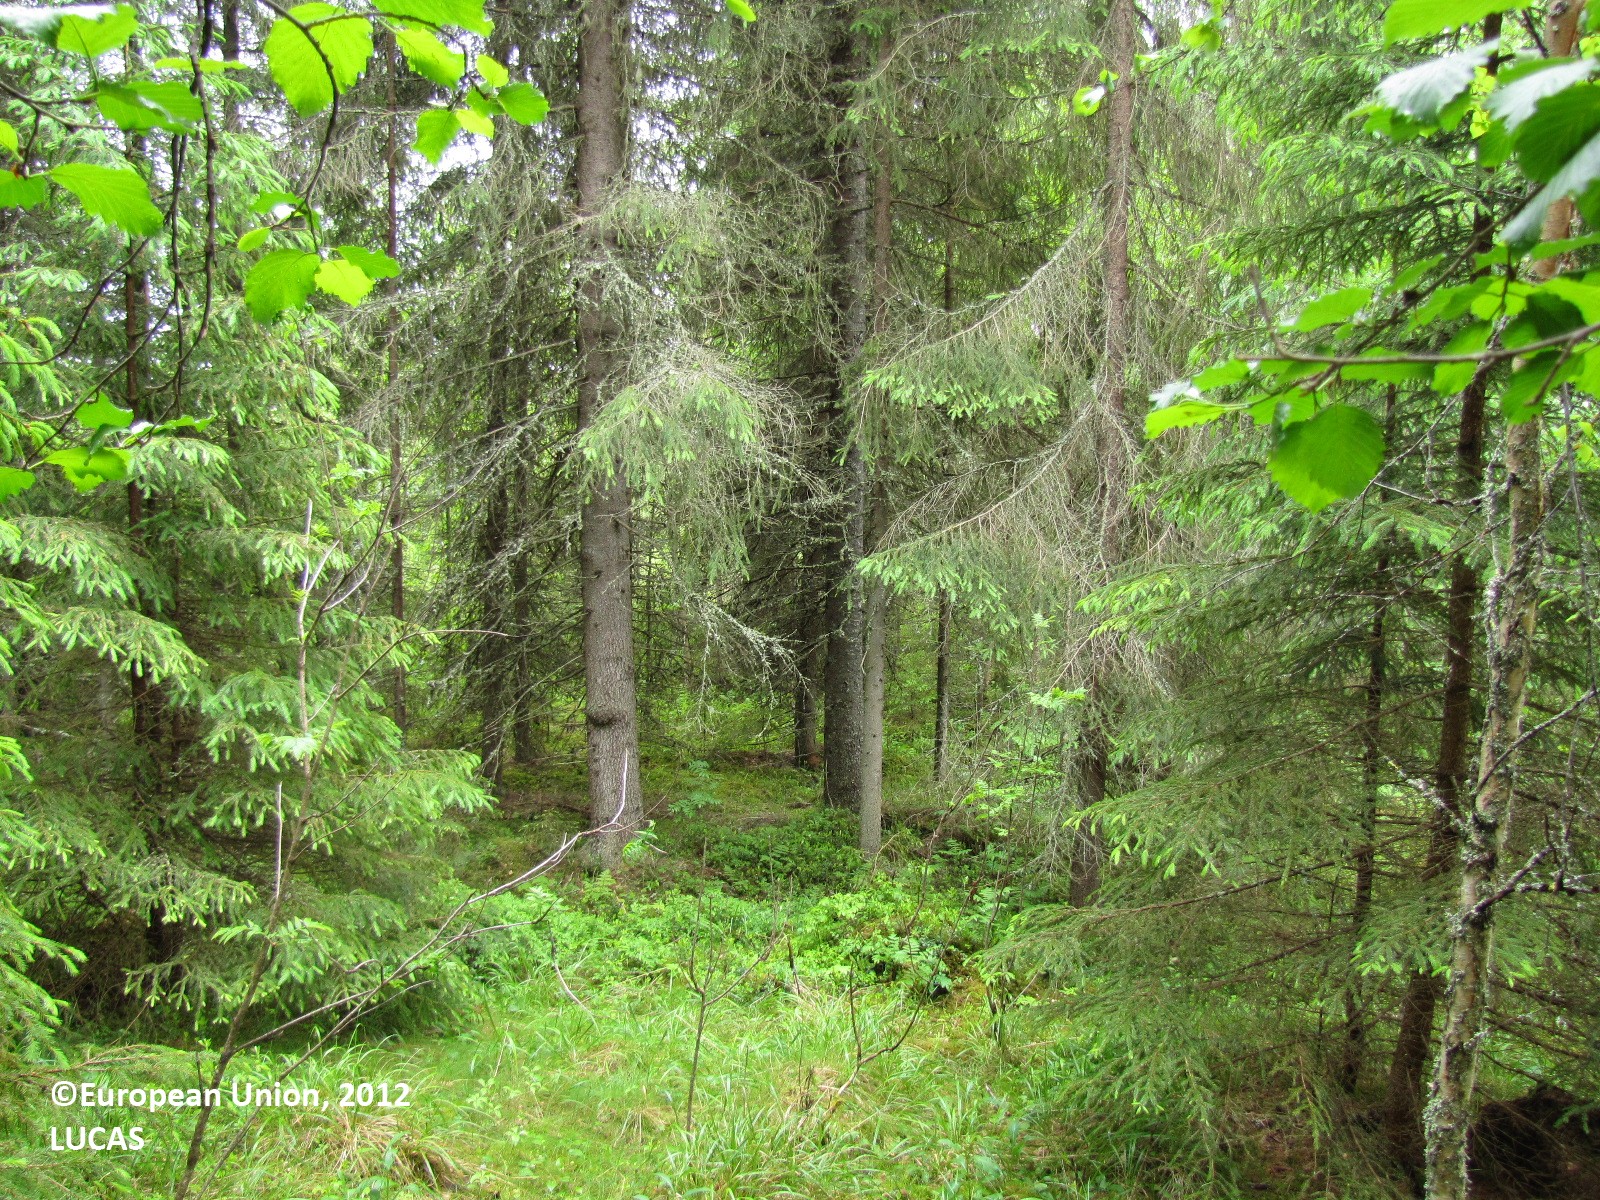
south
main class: Woodland
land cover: Spruce dominated coniferous woodland
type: boreal forest
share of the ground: 50 - 75 %
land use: Forestry
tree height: > 5 m
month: June
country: FI
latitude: 61.5516
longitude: 24.7244
